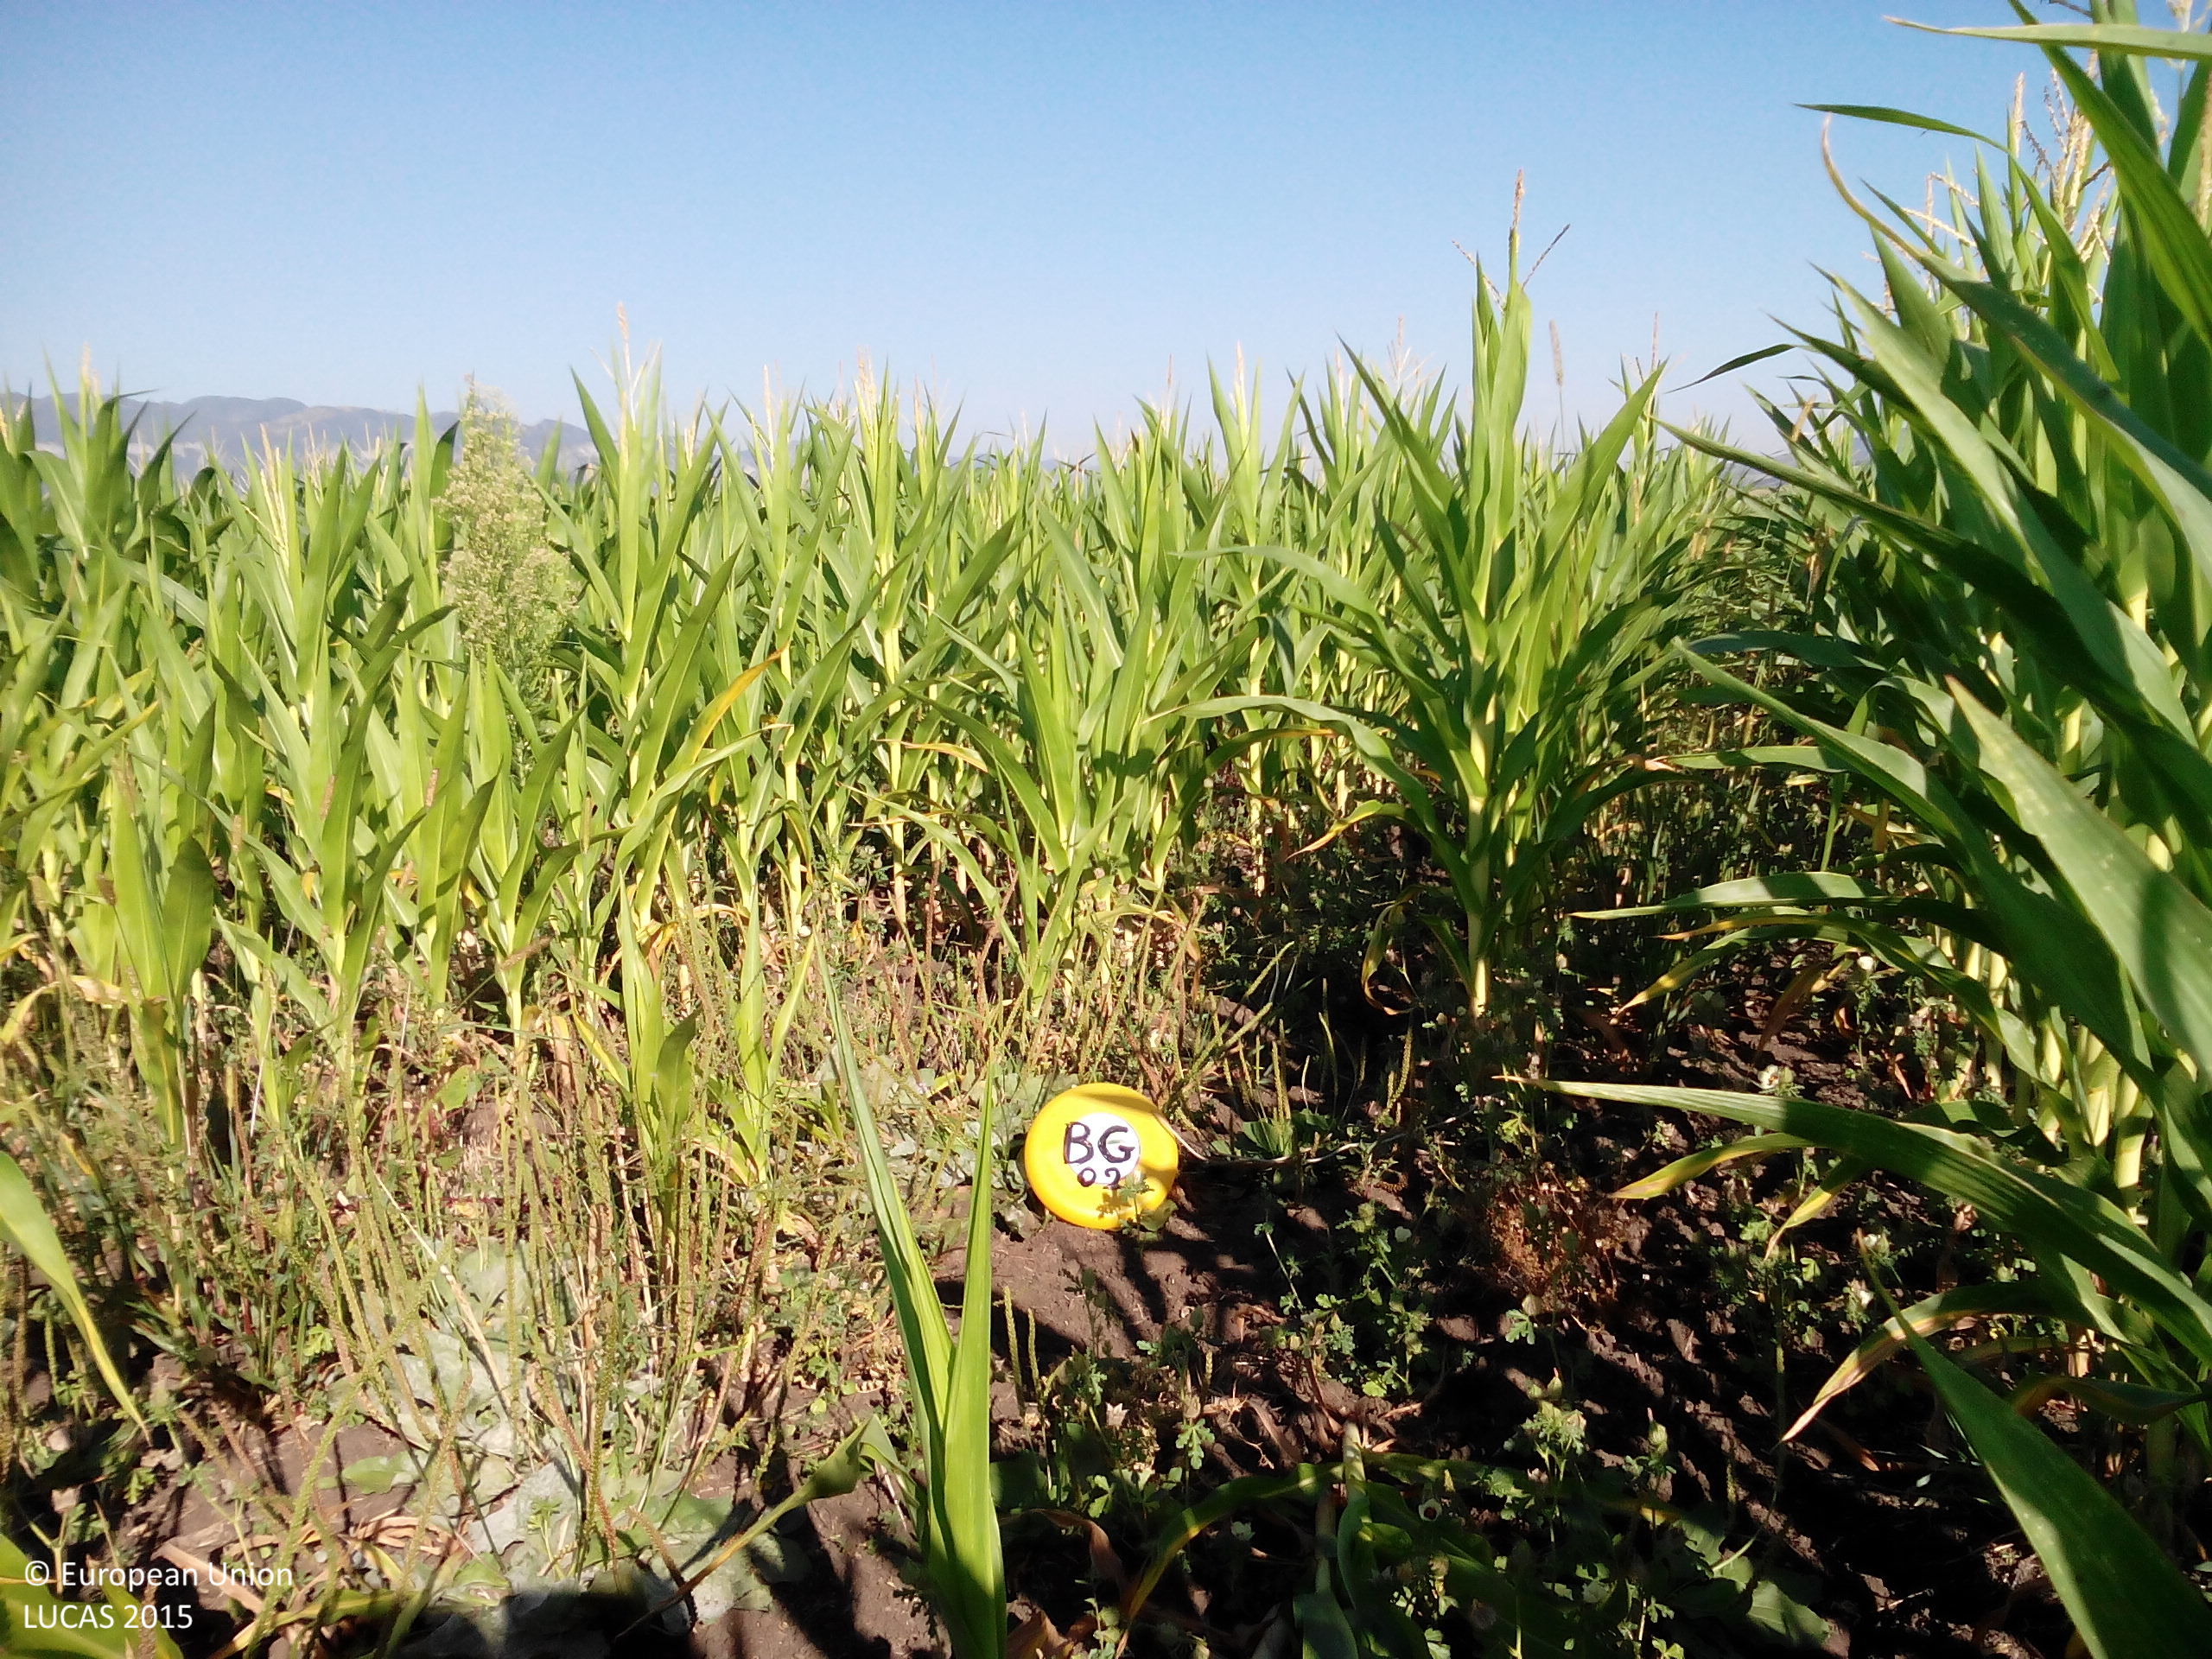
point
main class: Cropland
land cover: Maize
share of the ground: 50 - 75 %
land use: Agriculture (excluding fallow land and kitchen gardens)
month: August
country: BG
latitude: 43.1583
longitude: 23.7331
